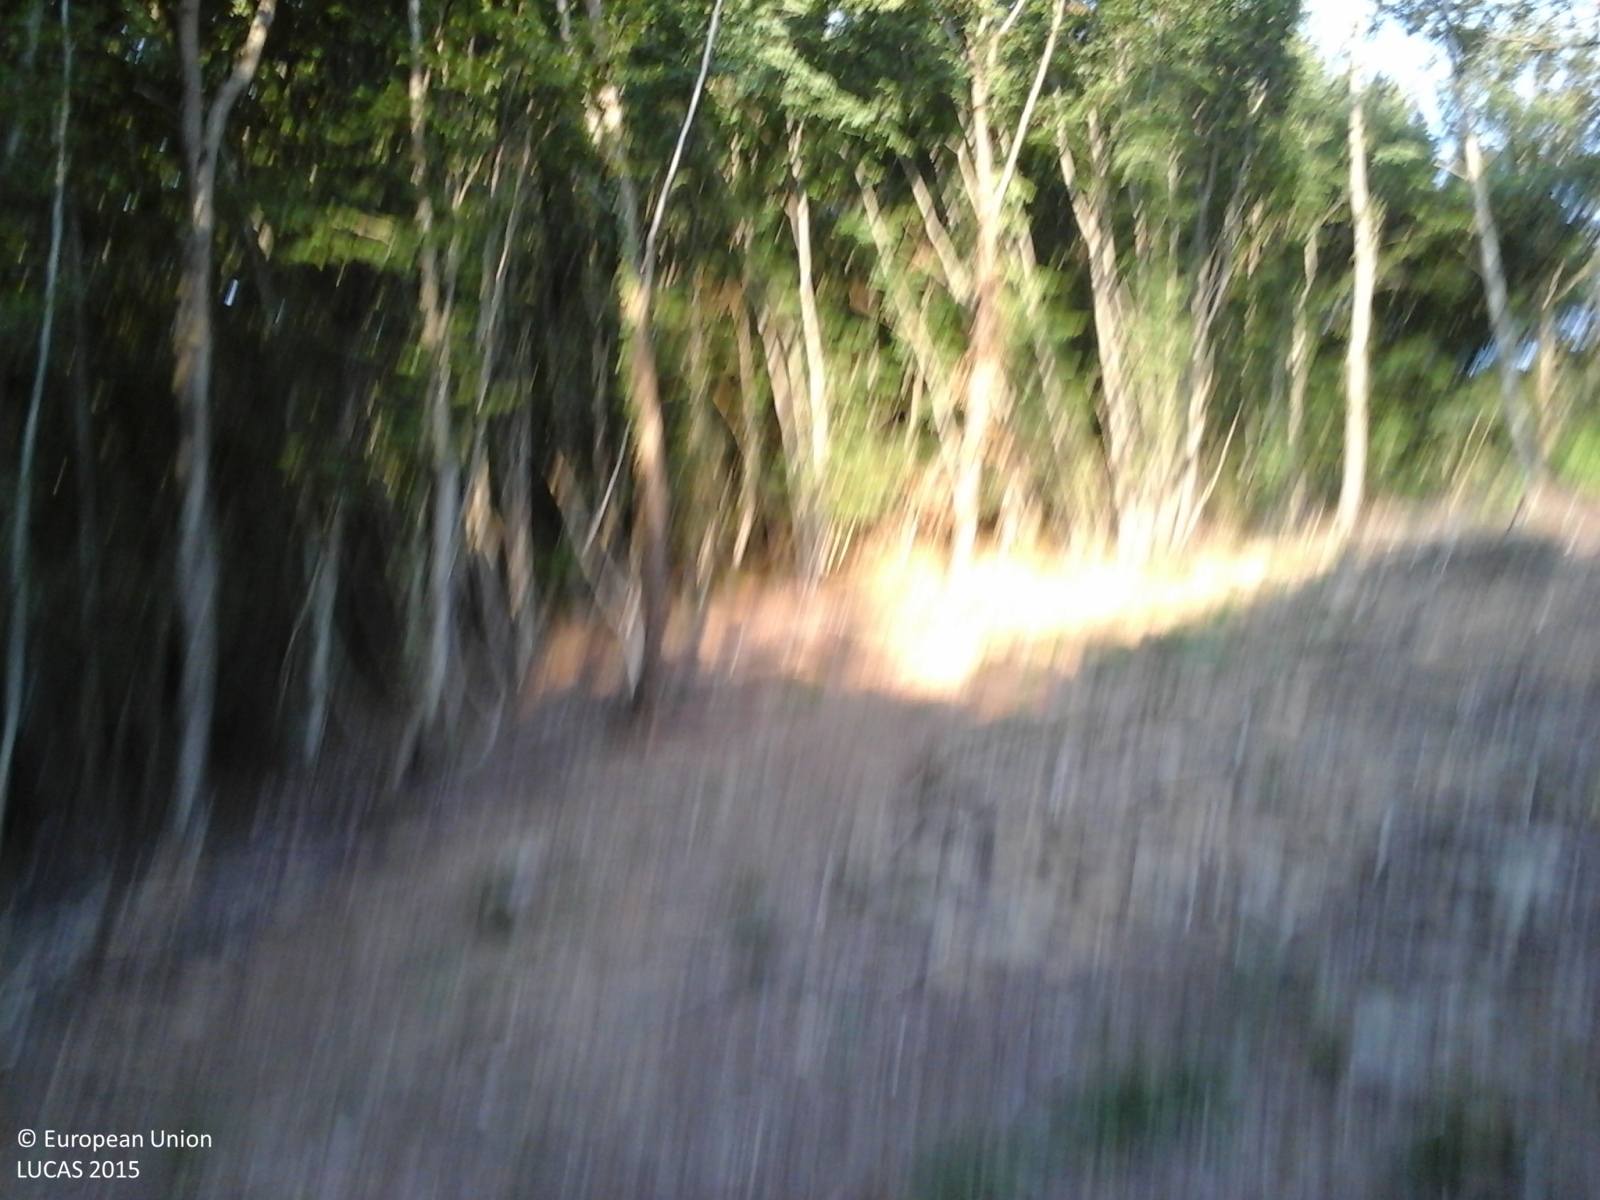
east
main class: Woodland
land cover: Broadleaved woodland
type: thermophilous deciduous forest
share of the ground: > 75 %
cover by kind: broadleaved forest trees 75 %, shrubs 20 %, herbaceous plants 5 %
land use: Forestry
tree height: > 5 m
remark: Clear cut
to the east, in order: Broadleaved woodland; Paved roads, cycling and walking lanes; Broadleaved woodland
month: August
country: IT
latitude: 42.8040
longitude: 11.5967
